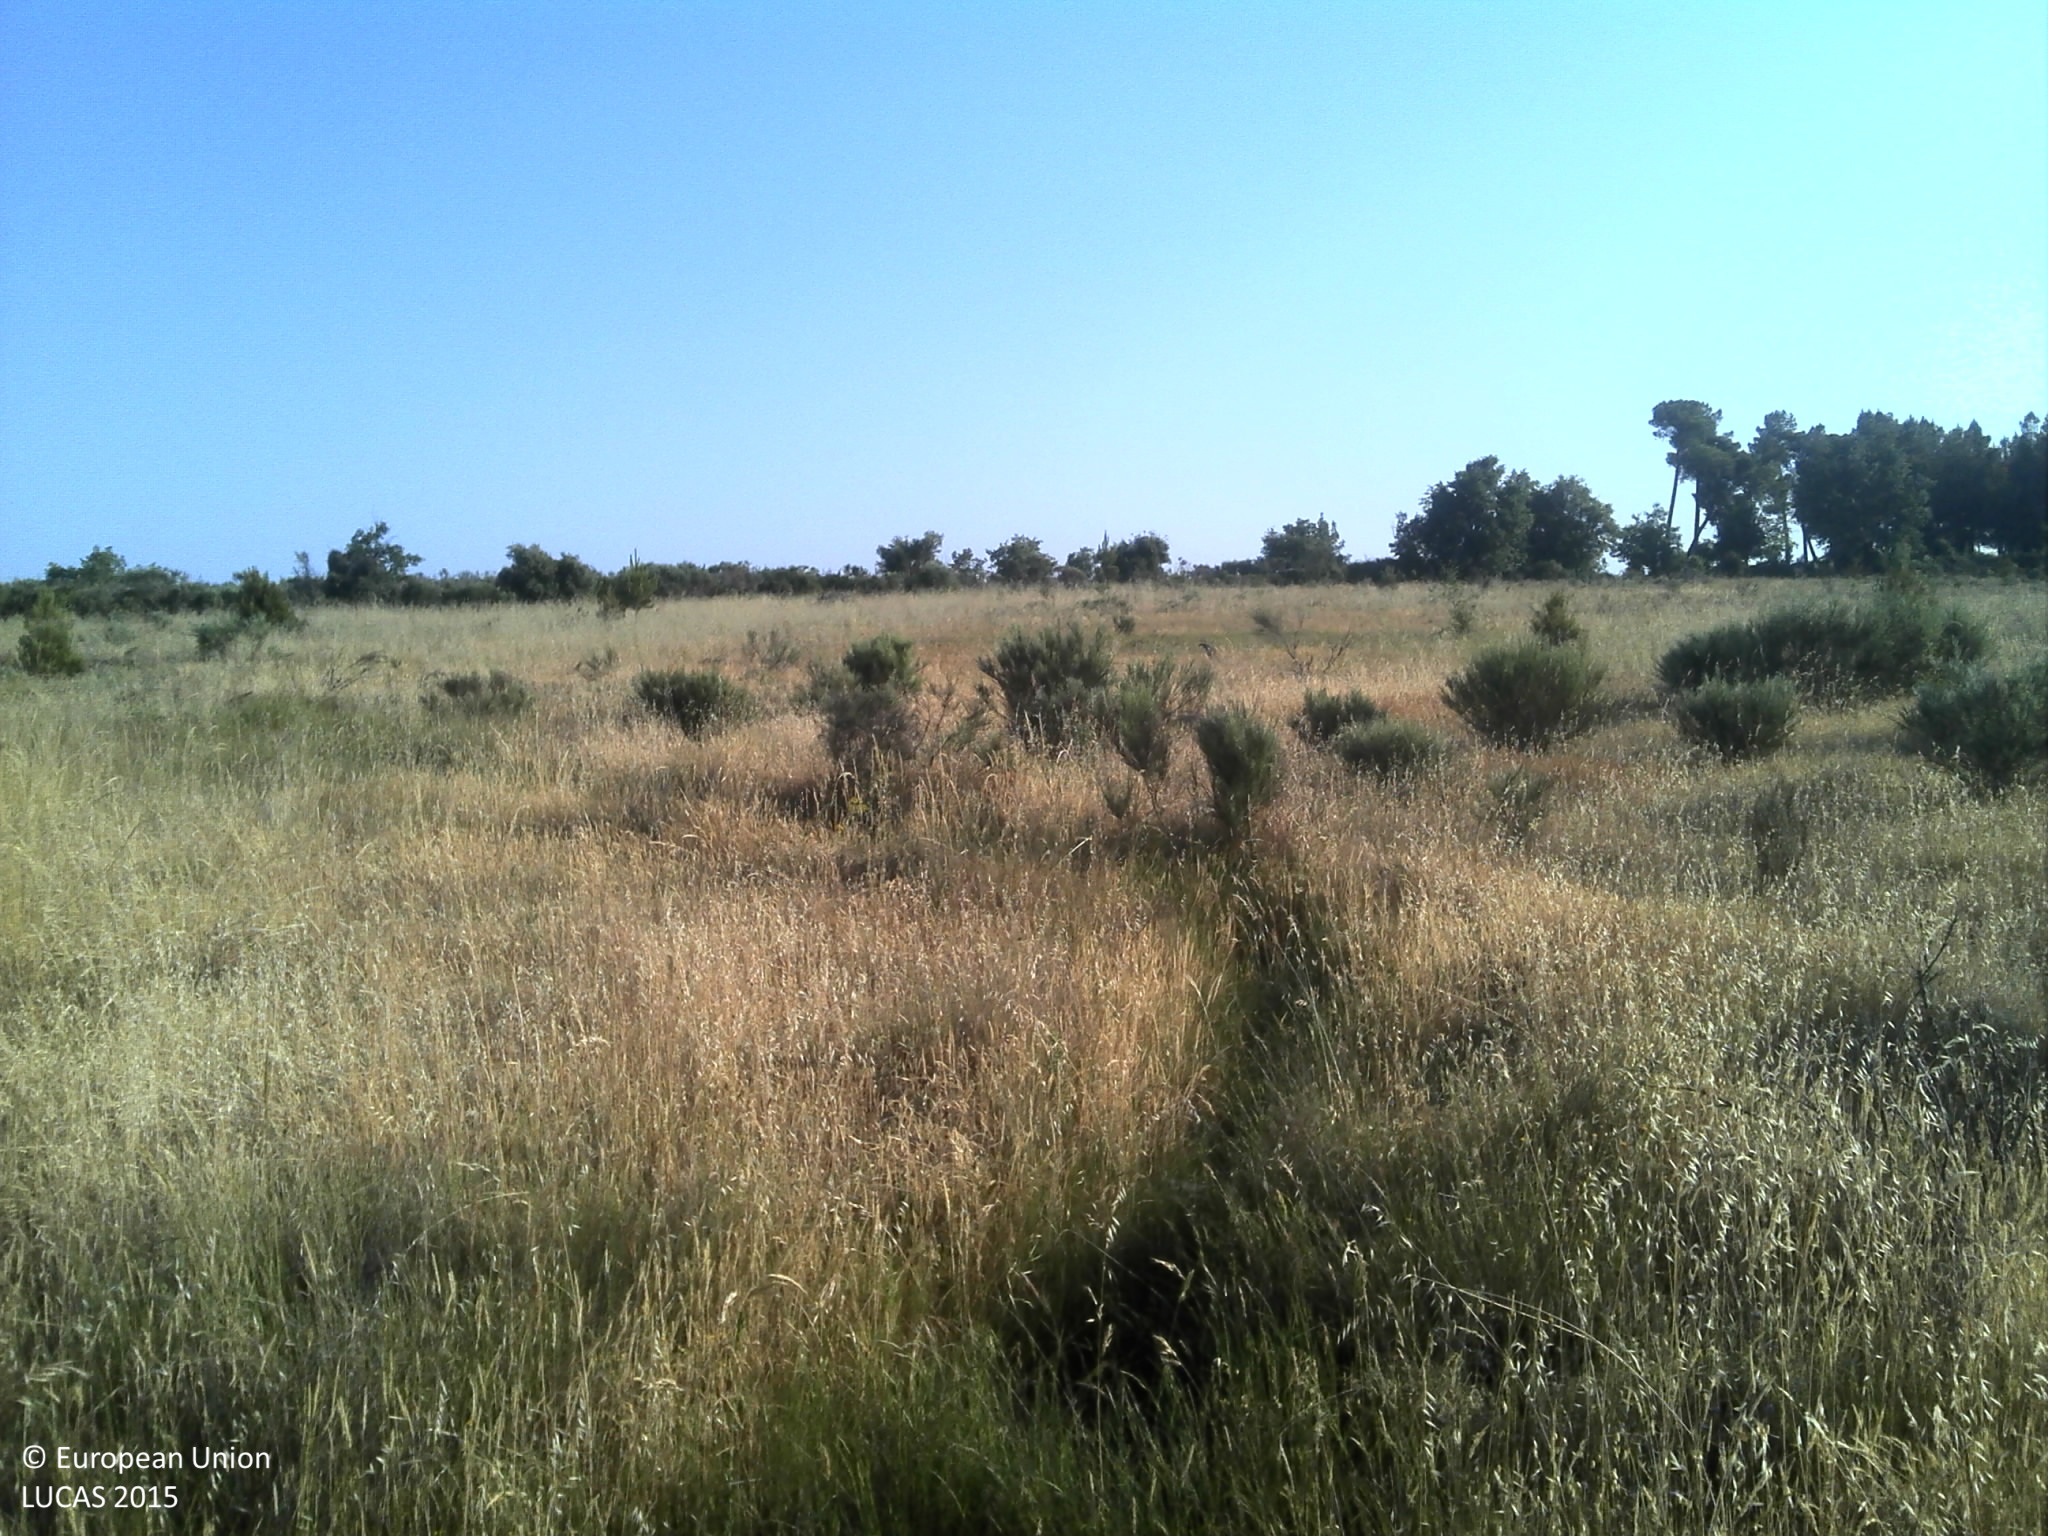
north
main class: Grassland
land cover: Grassland without tree/shrub cover
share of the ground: 50 - 75 %
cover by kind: herbaceous plants 70 %, unconsolidated bare surface 20 %
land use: Agriculture (excluding fallow land and kitchen gardens)
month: June
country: PT
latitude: 40.5637
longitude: -6.9772
